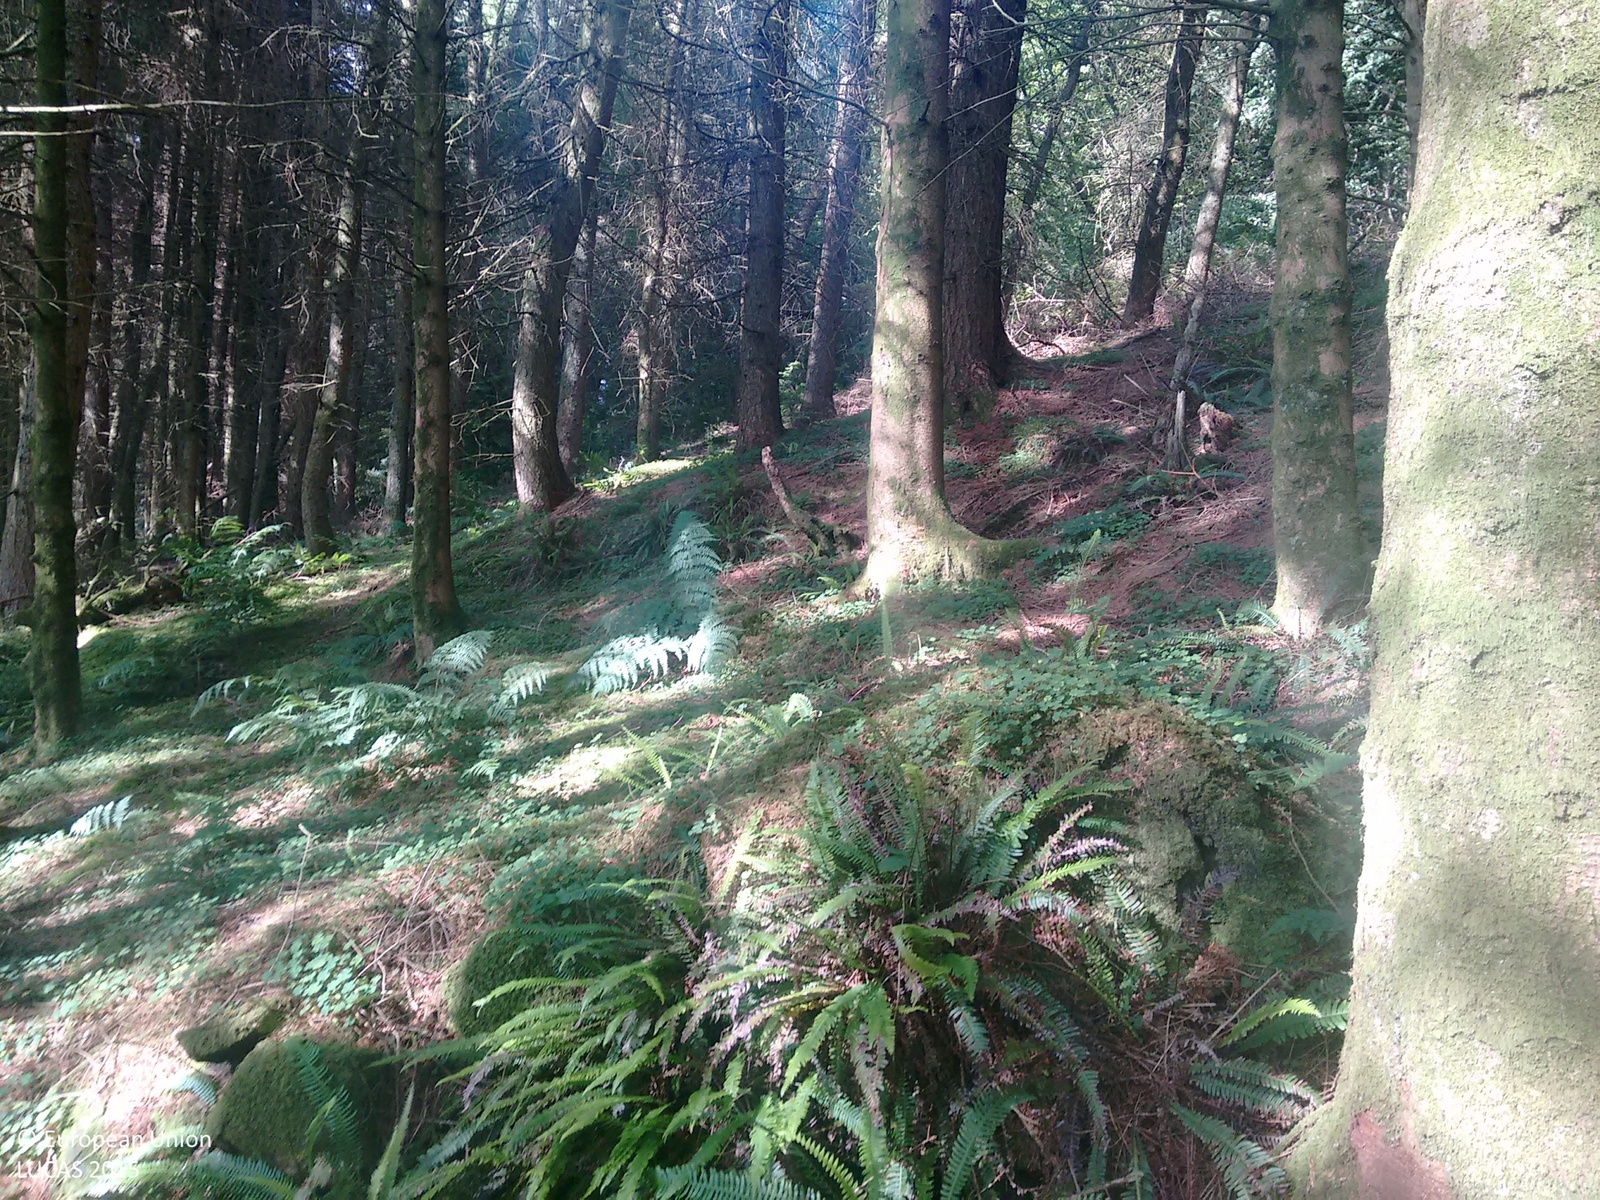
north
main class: Woodland
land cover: Pine dominated coniferous woodland
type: exotic forest
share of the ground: > 75 %
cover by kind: coniferous forest trees 90 %, broadleaved forest trees 10 %
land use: Forestry
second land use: Amenities, museums, leisure
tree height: > 5 m
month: July
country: GB
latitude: 55.5194
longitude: -5.1460
